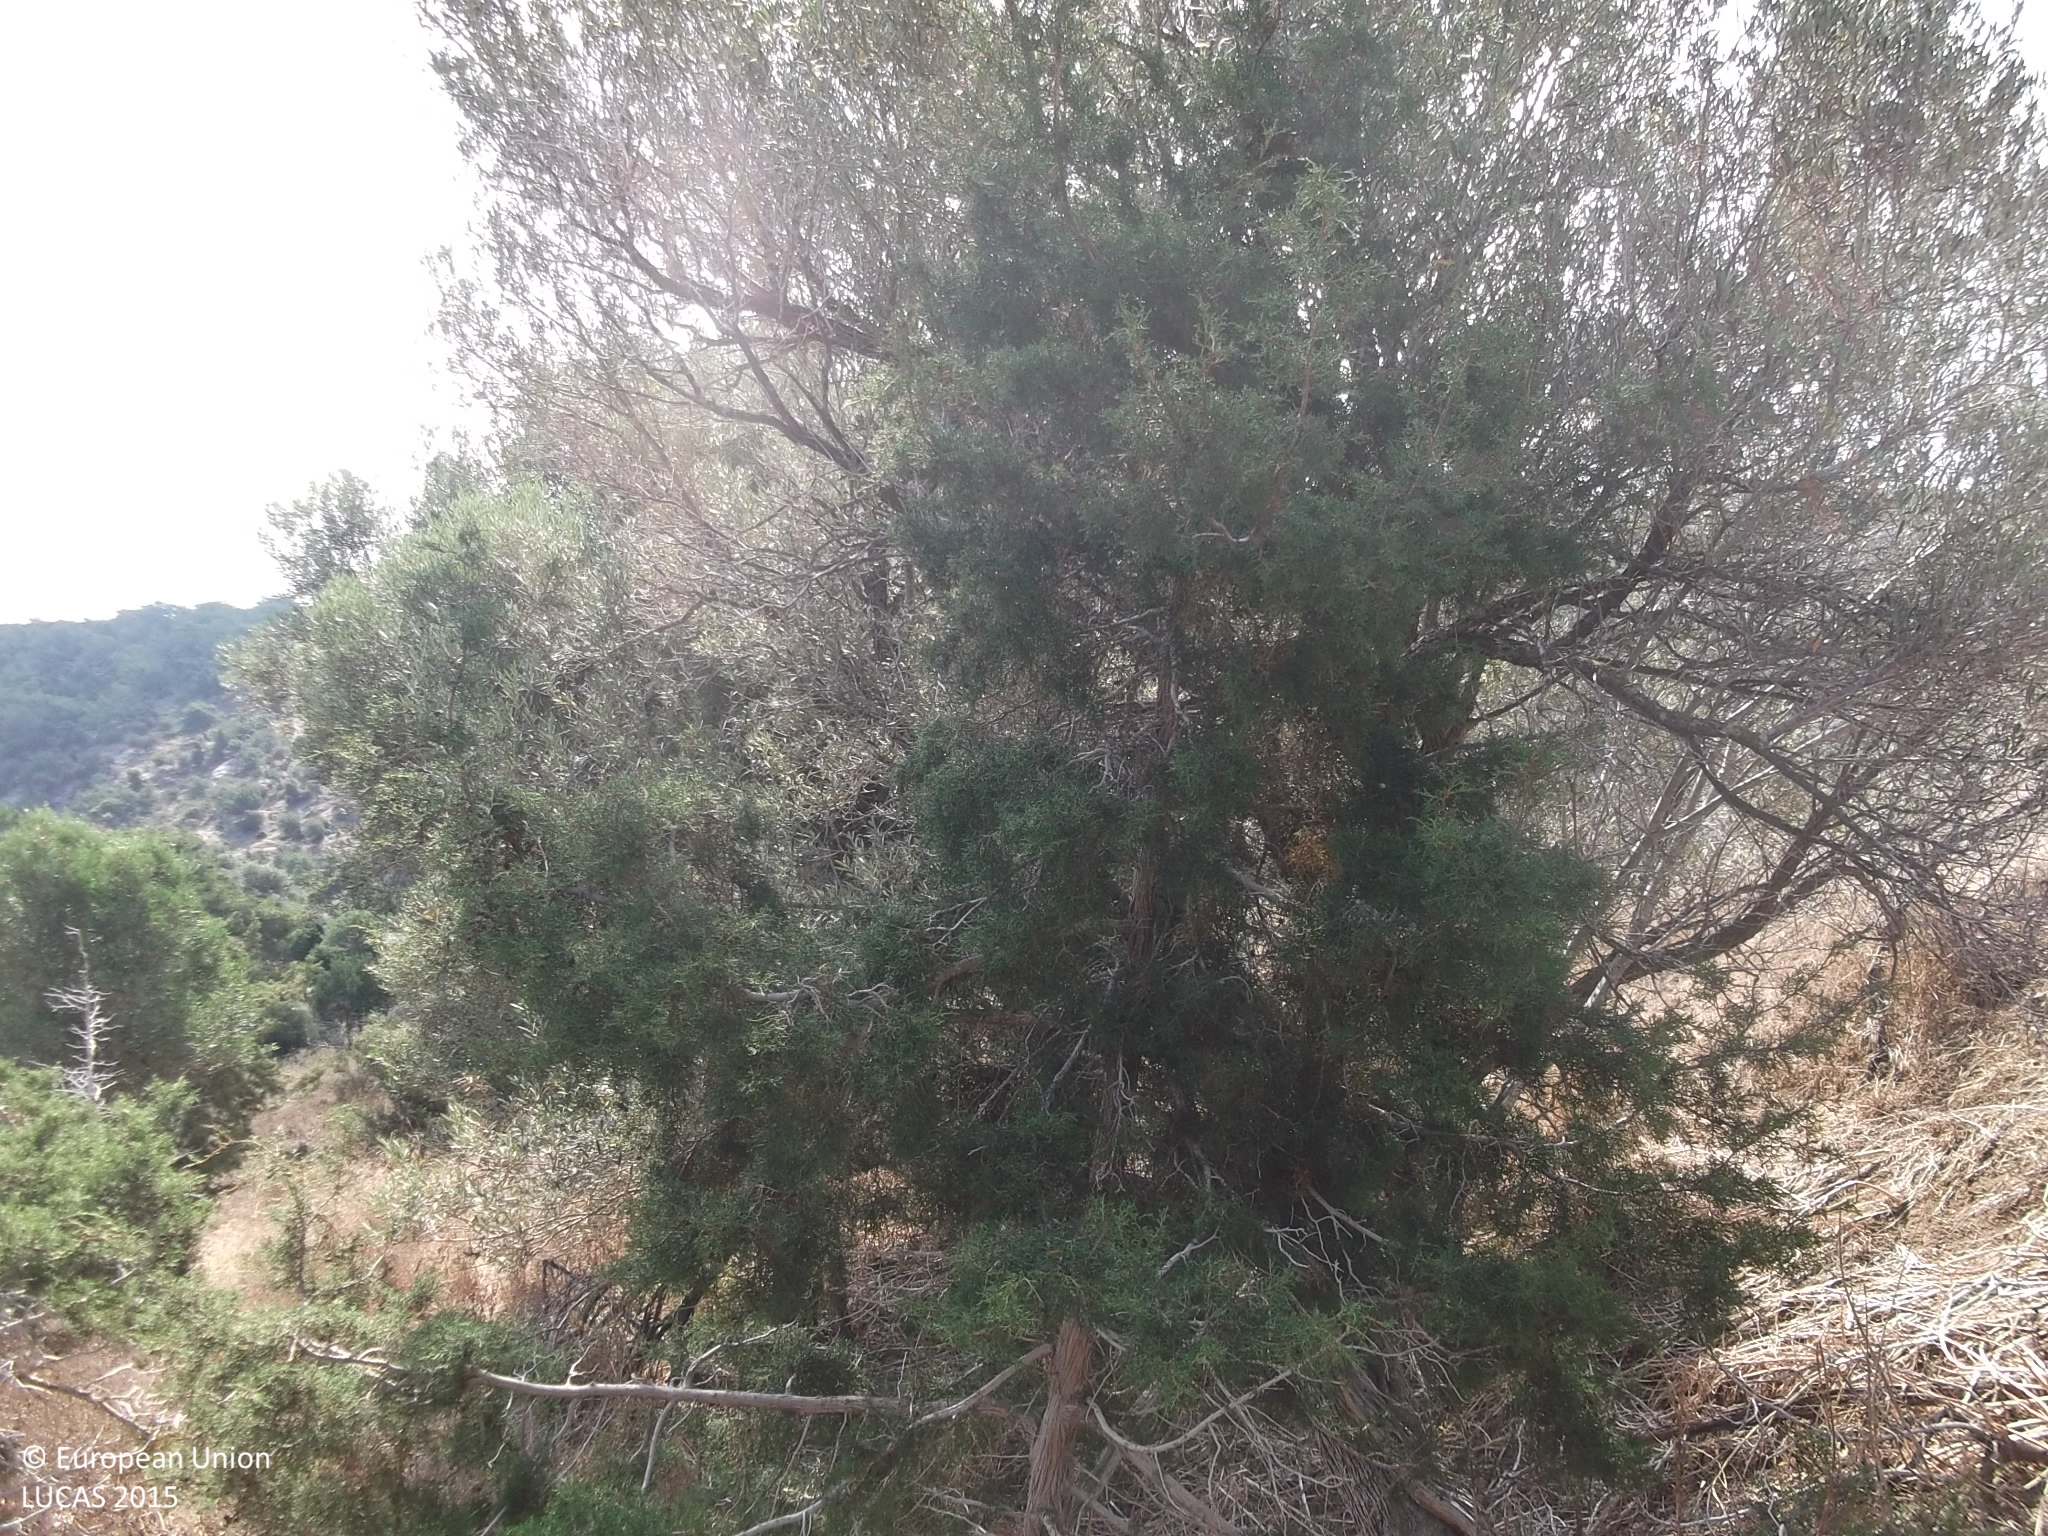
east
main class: Woodland
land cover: Other mixed woodland
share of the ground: 50 - 75 %
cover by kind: herbaceous plants 50 %, coniferous forest trees 30 %, broadleaved forest trees 20 %
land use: Agriculture (excluding fallow land and kitchen gardens)
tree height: < 5 m
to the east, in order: Other mixed woodland; Shrubland with sparse tree cover; Tracks; Grassland with sparse tree/shrub cover; Other coniferous woodland; Shrubland with sparse tree cover; Other coniferous woodland
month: May
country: CY
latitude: 35.0837
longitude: 32.2944
